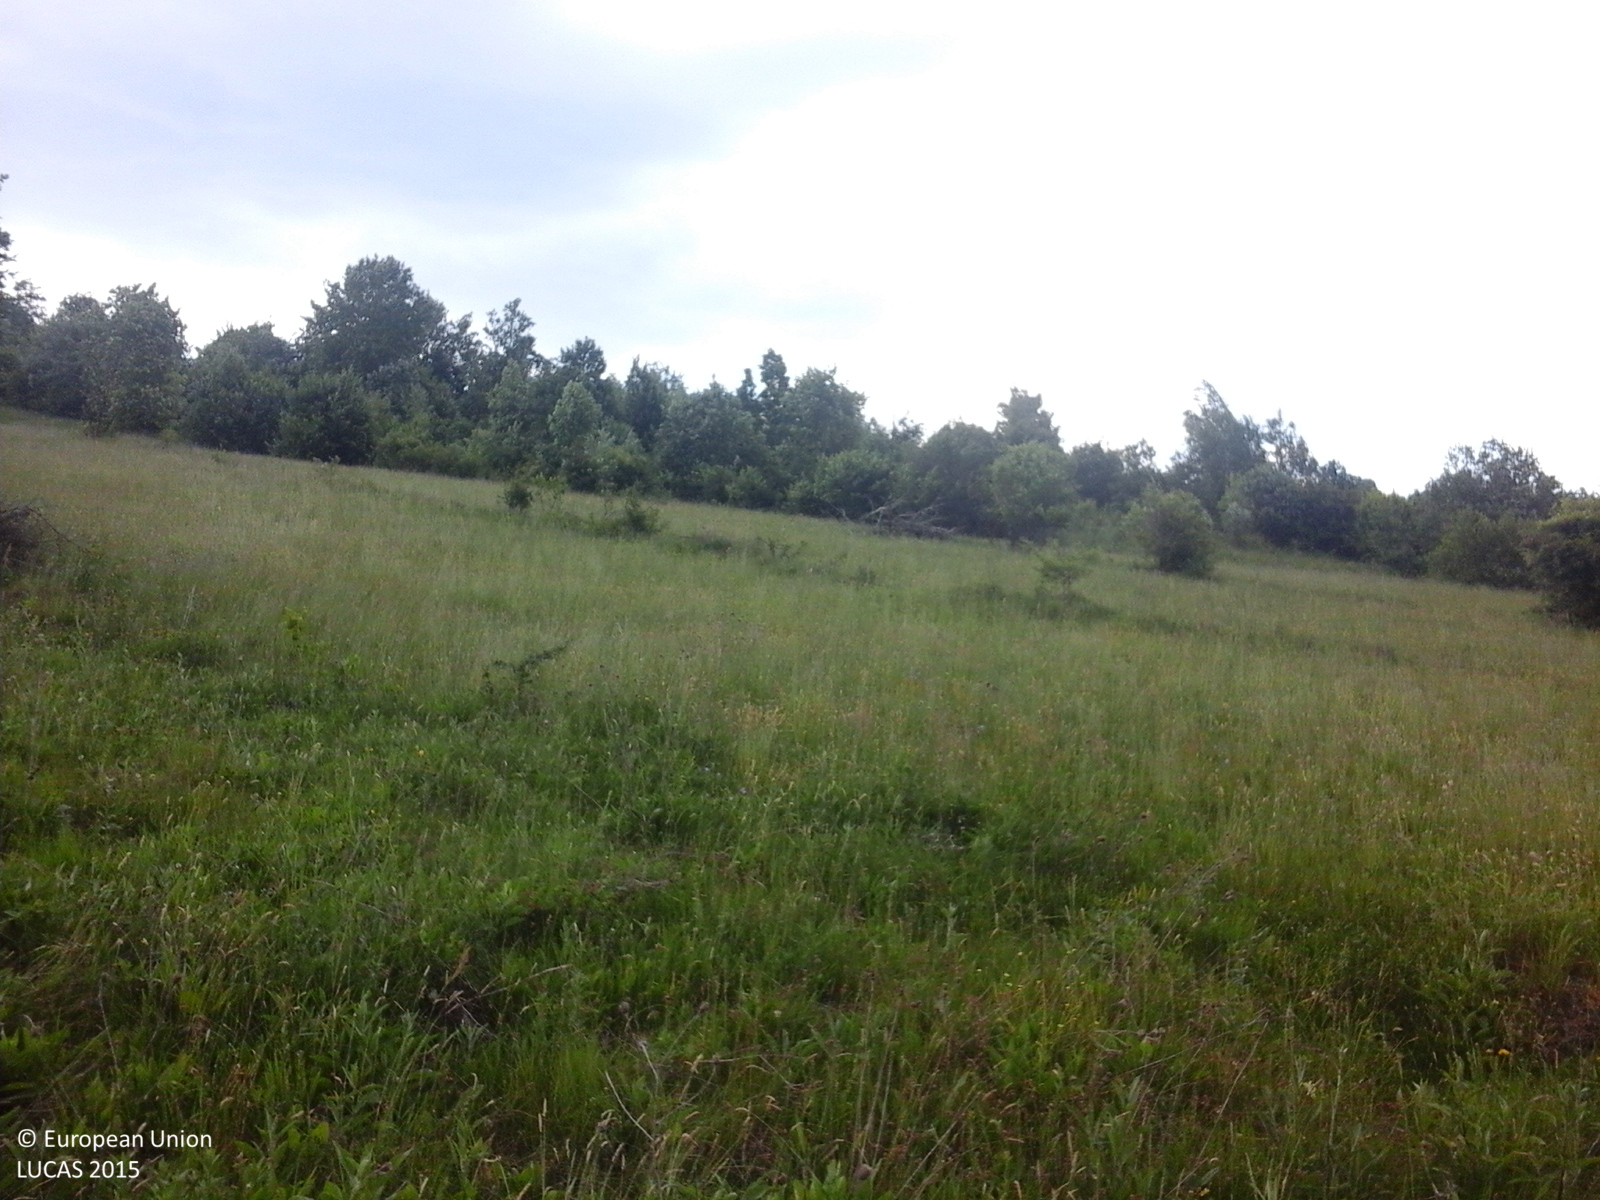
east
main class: Grassland
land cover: Grassland without tree/shrub cover
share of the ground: > 75 %
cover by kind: herbaceous plants 95 %, shrubs 5 %
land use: Agriculture (excluding fallow land and kitchen gardens)
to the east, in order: Grassland without tree/shrub cover; Lines of trees; Grassland without tree/shrub cover; Lines of trees; Grassland without tree/shrub cover; Lines of trees; Shrubland with sparse tree cover; Grassland with sparse tree/shrub cover; Shrubland with sparse tree cover; Grassland without tree/shrub cover; Shrubland with sparse tree cover
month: June
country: RO
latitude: 46.7331
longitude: 26.4802
